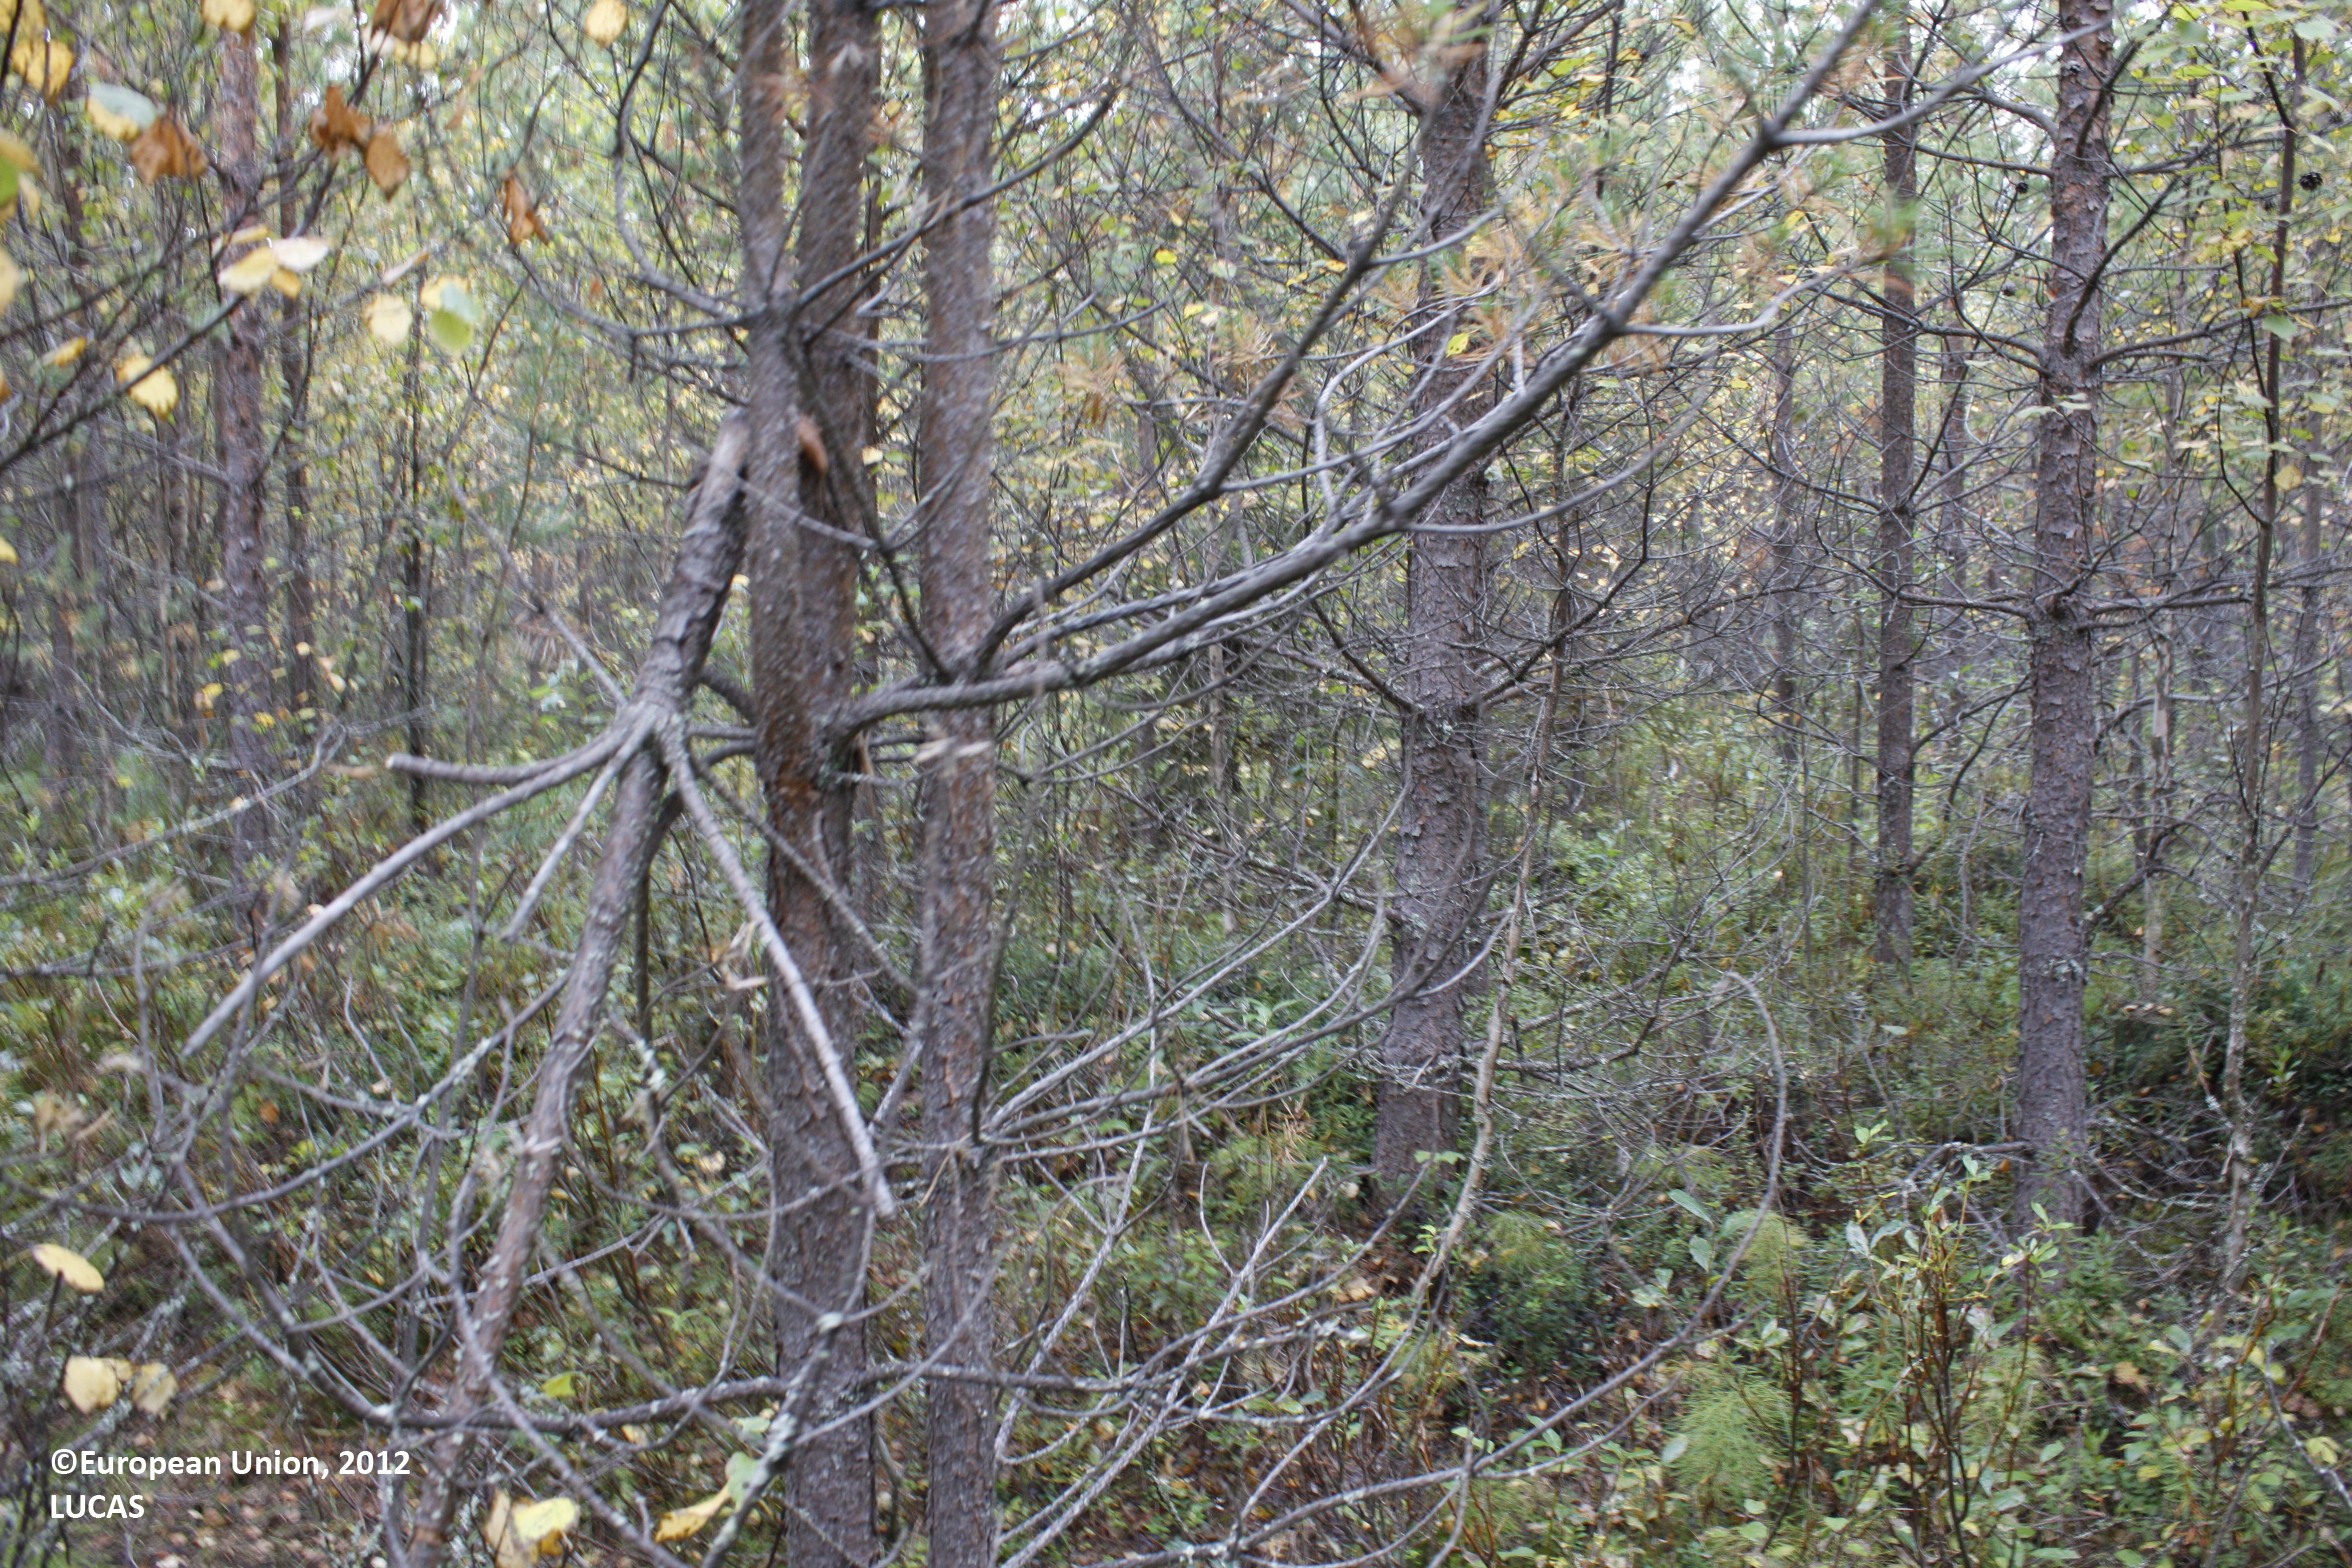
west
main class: Woodland
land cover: Pine dominated mixed woodland
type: mire and swamp forests
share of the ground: > 75 %
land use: Forestry
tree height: > 5 m
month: September
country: FI
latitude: 65.3666
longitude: 26.8184
